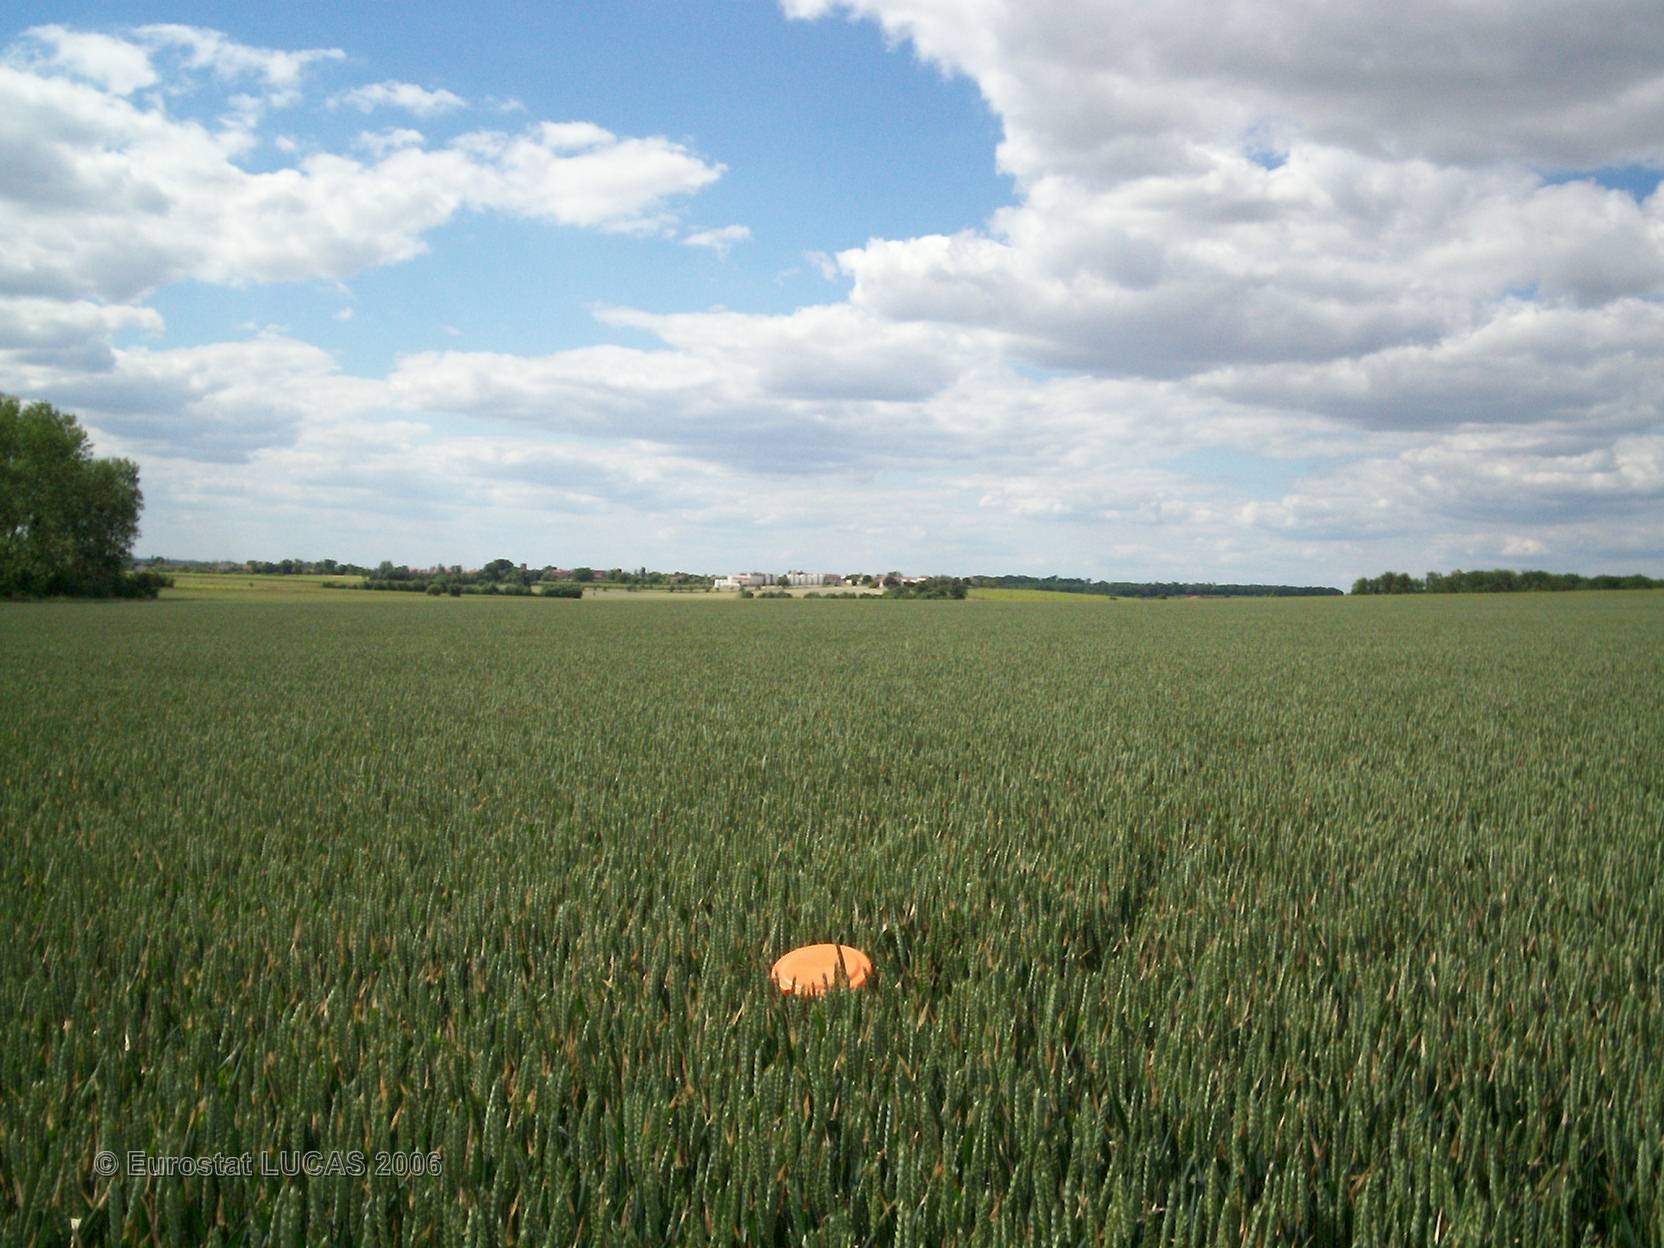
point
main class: Cropland
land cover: Common wheat
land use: Agriculture (excluding fallow land and kitchen gardens)
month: May
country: FR
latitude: 45.7902
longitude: -0.1955
